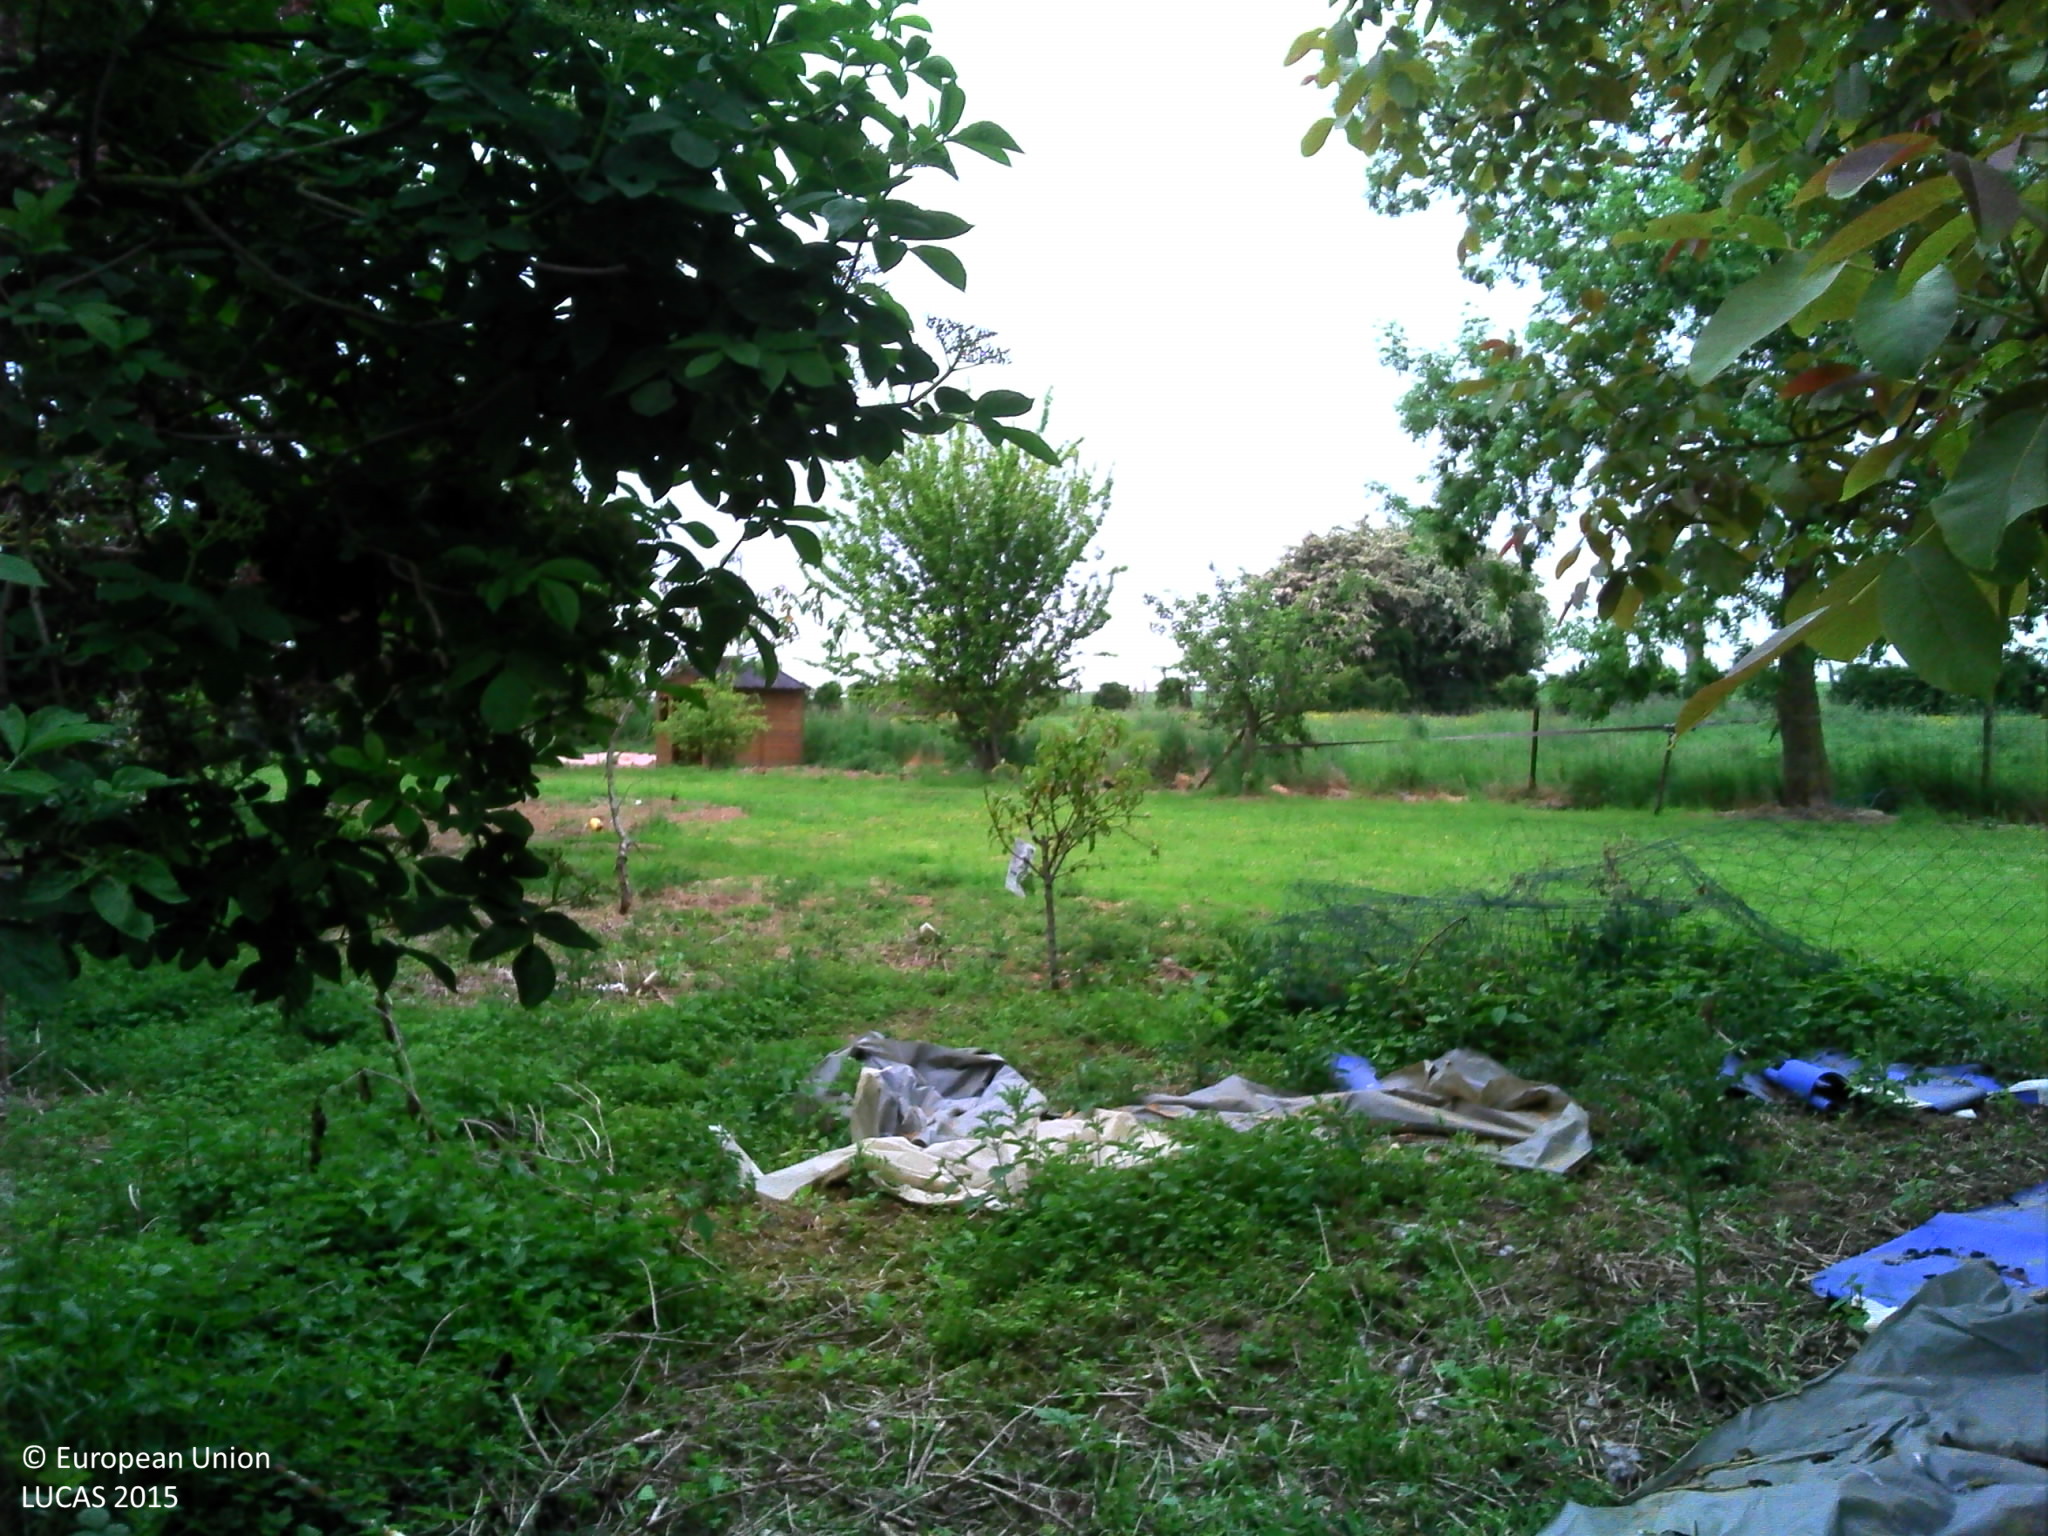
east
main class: Woodland
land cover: Broadleaved woodland
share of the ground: 50 - 75 %
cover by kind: broadleaved forest trees 60 %, herbaceous plants 40 %
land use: Residential
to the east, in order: Broadleaved woodland; Grassland with sparse tree/shrub cover; Fences; Grassland without tree/shrub cover; Electric lines; Grassland without tree/shrub cover; Fences; Grass margins; Common wheat
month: May
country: FR
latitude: 50.6090
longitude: 2.2847
